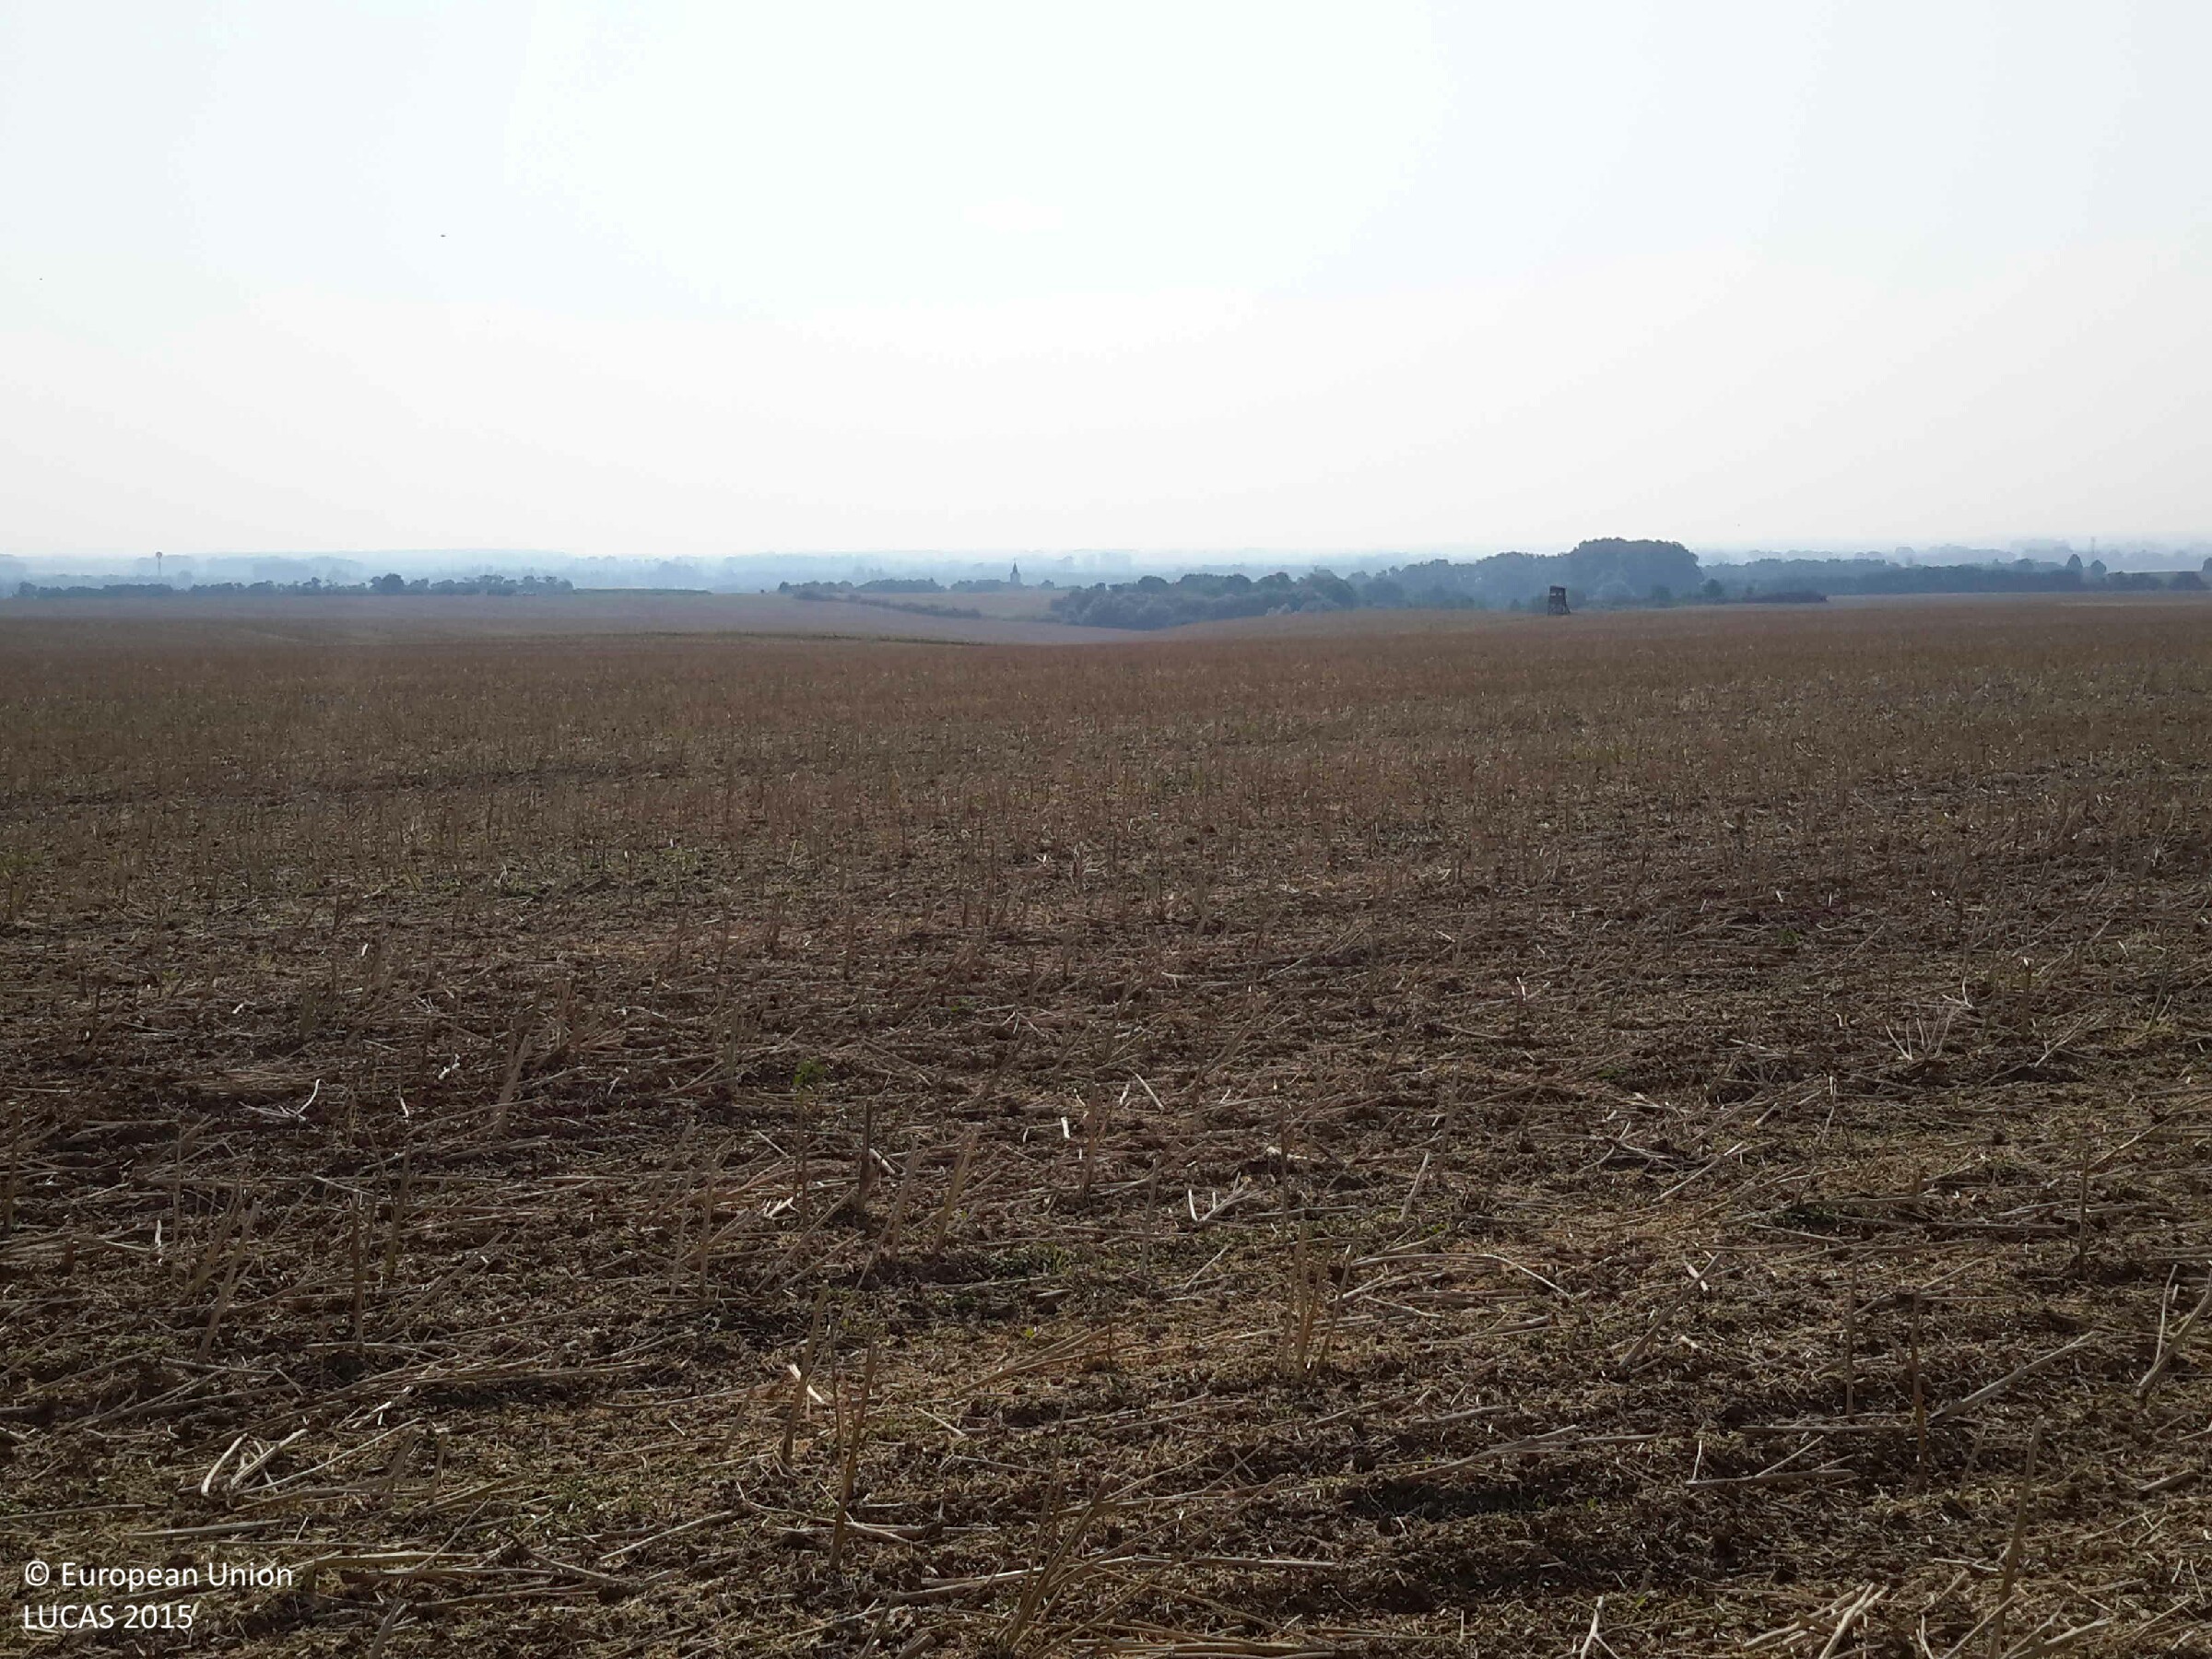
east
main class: Cropland
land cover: Rape and turnip rape
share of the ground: 10 - 25 %
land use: Agriculture (excluding fallow land and kitchen gardens)
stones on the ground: < 10 %
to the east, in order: Rape and turnip rape
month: July
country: HU
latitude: 47.4450
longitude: 16.6482
